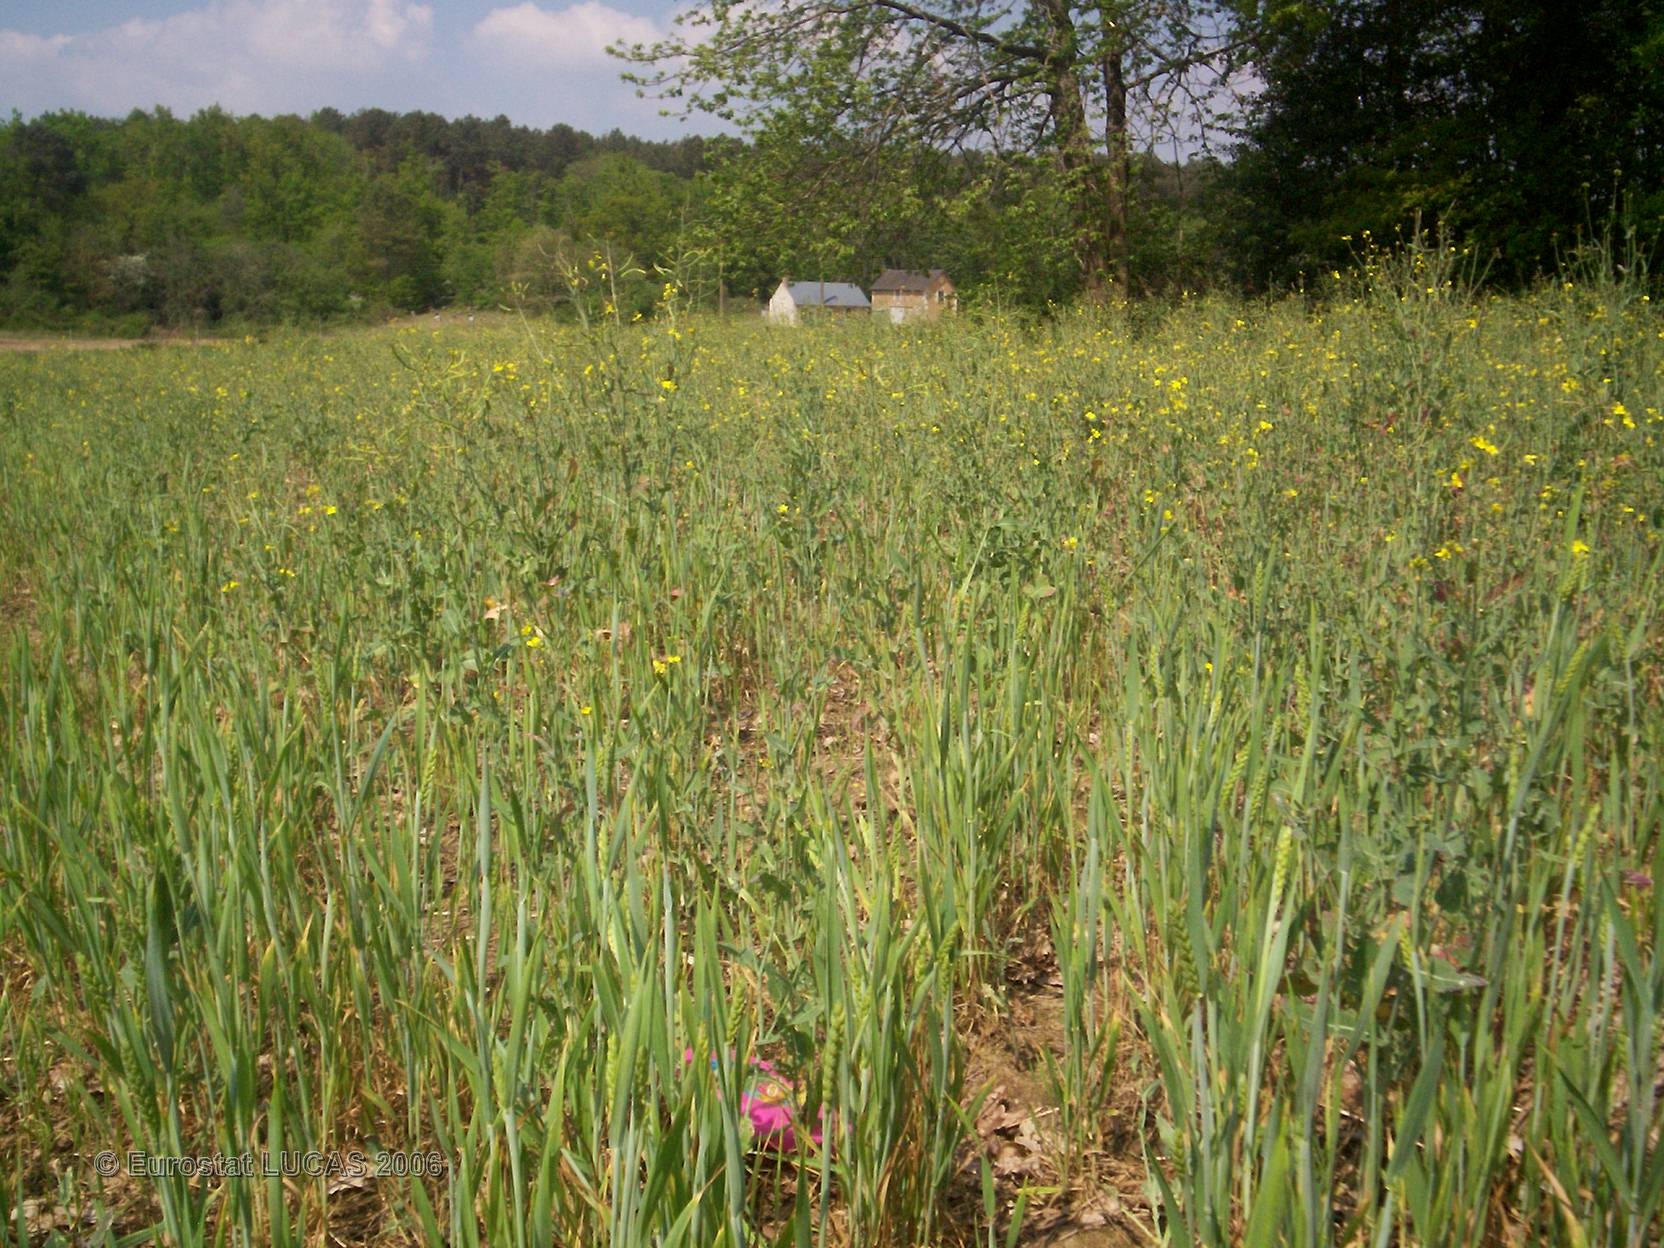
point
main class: Cropland
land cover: Rape and turnip rape
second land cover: Common wheat
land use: Agriculture (excluding fallow land and kitchen gardens)
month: May
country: FR
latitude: 47.6758
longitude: 0.1851
